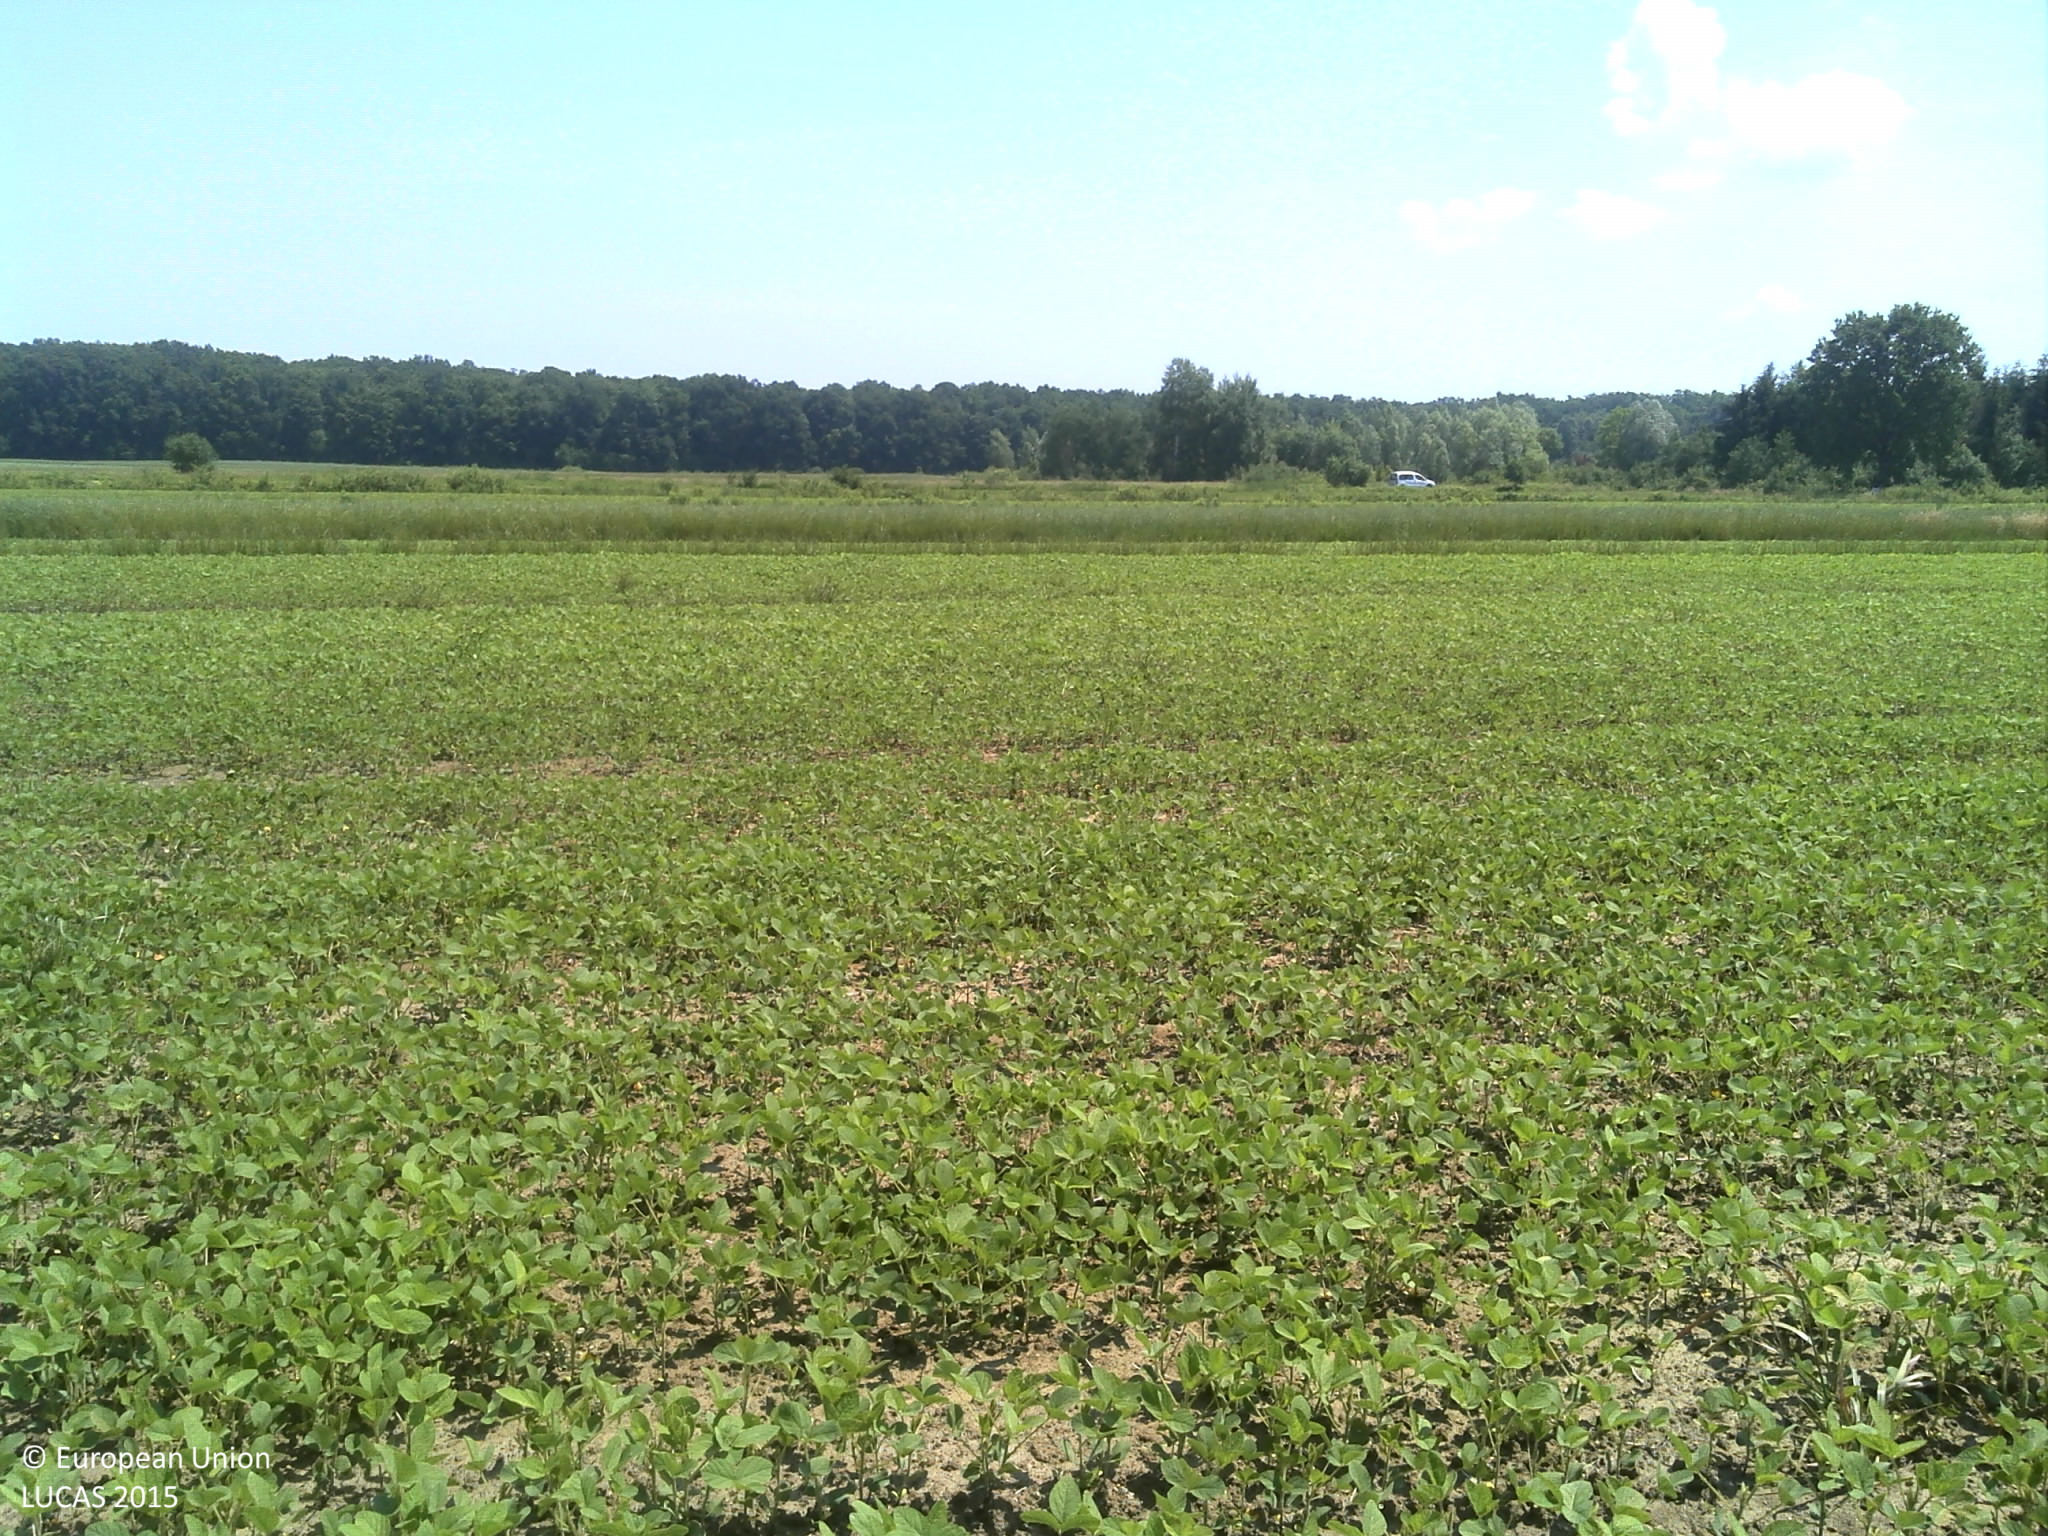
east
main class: Cropland
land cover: Soya
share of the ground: 25 - 50 %
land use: Agriculture (excluding fallow land and kitchen gardens)
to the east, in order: Soya; Common wheat; Maize; Soya; Ditches and canals; Soya; Tracks; Soya; Spontaneously vegetated surfaces; Soya
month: June
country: HR
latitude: 45.6531
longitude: 17.9990
